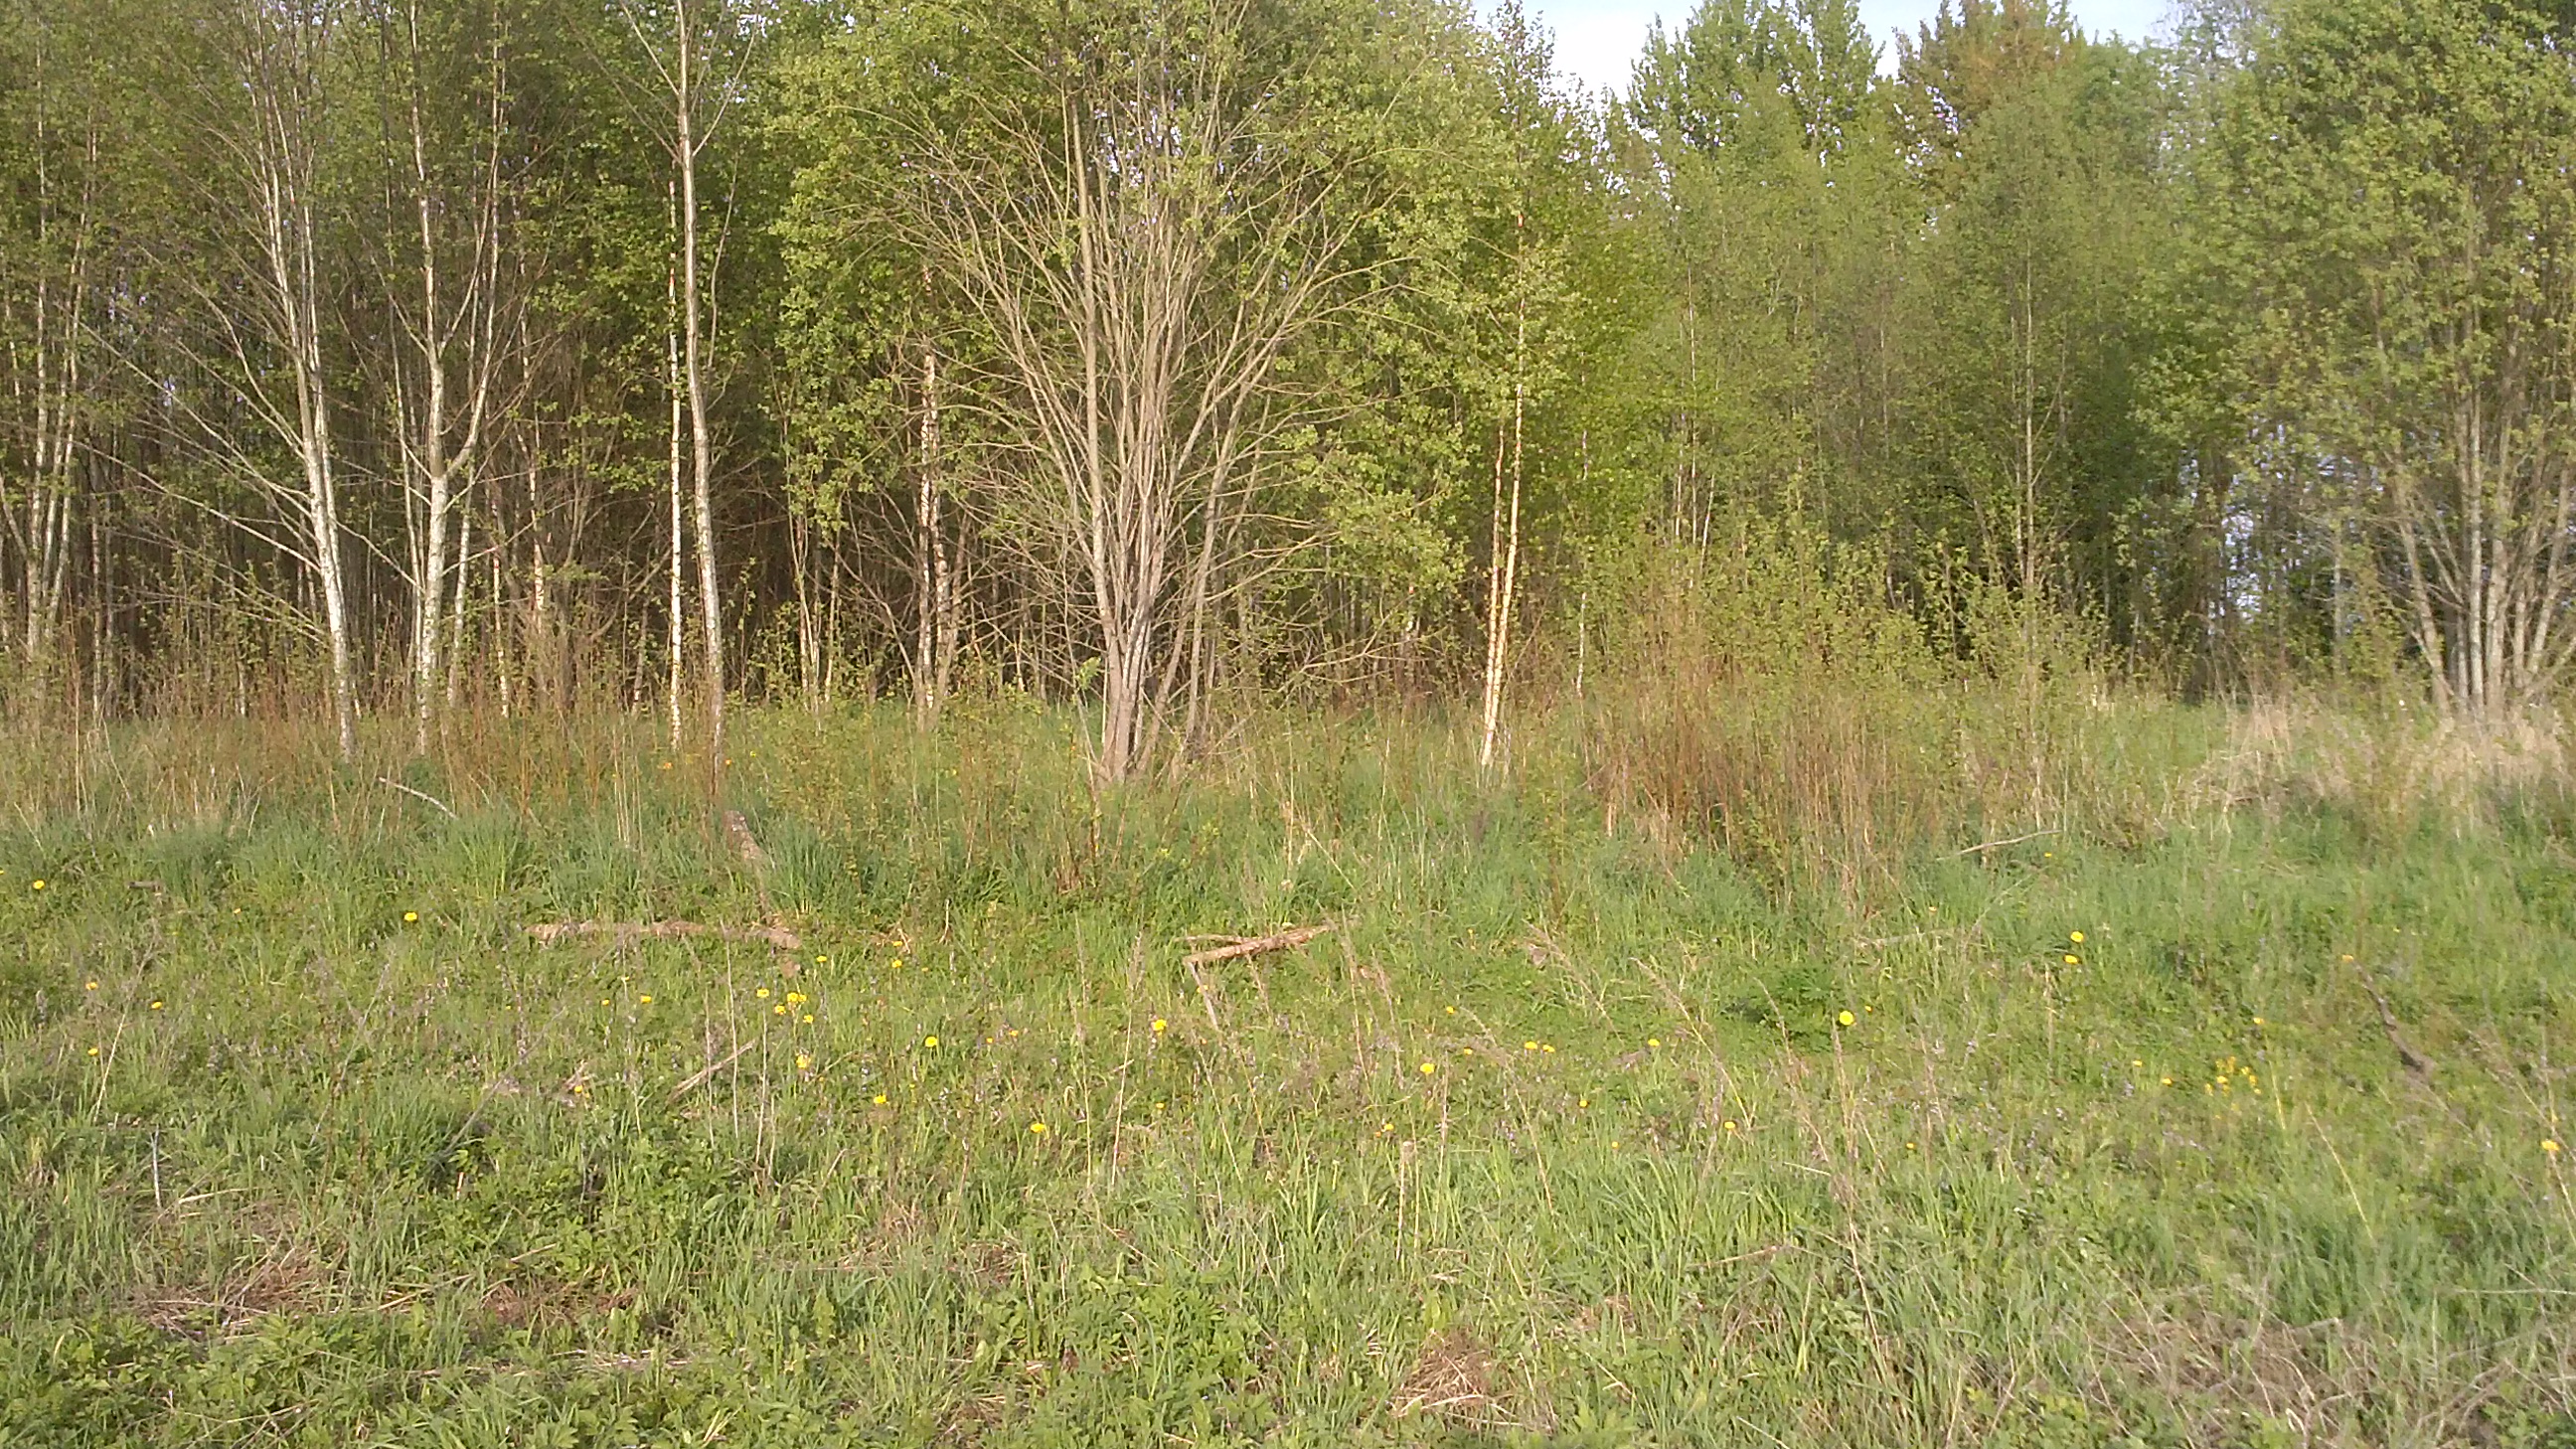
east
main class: Woodland
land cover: Broadleaved woodland
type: non-riverine alder, birch or aspen forest
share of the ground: > 75 %
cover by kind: broadleaved forest trees 100 %
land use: Forestry
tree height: > 5 m
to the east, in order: Broadleaved woodland
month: May
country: LV
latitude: 56.0013
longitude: 27.7819
